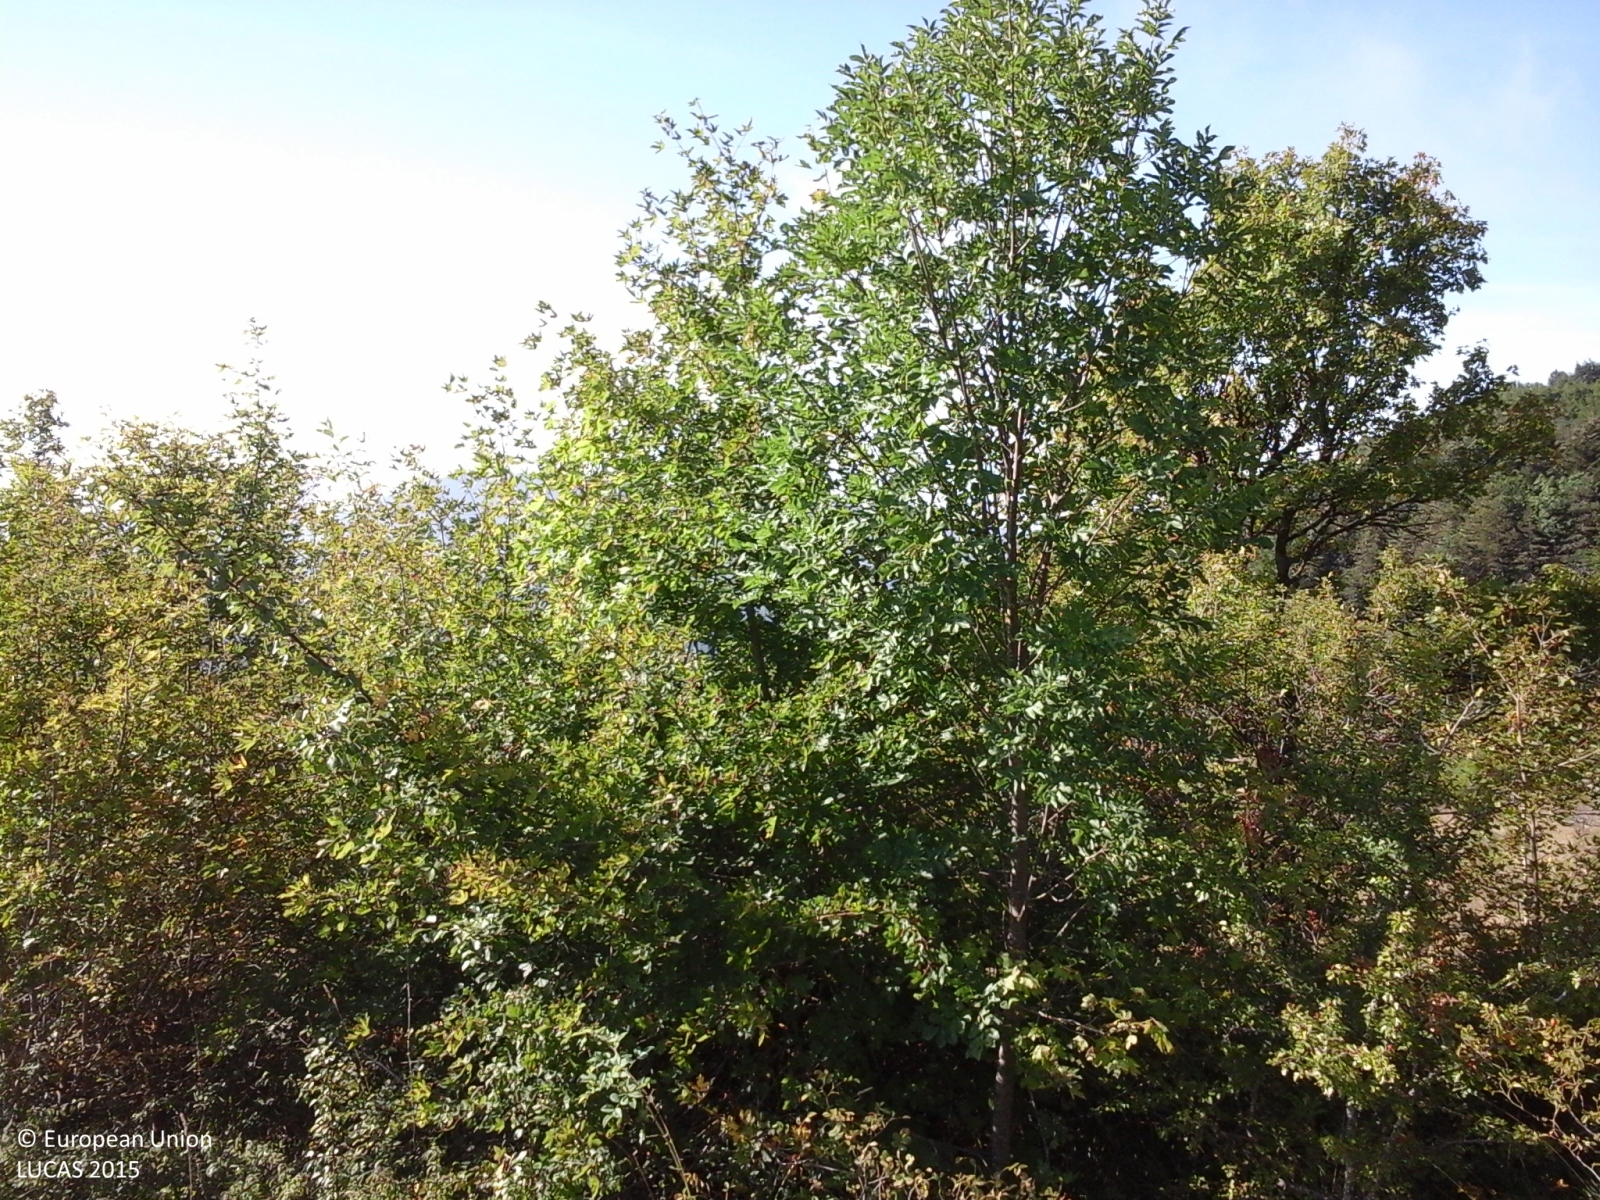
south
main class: Grassland
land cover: Grassland with sparse tree/shrub cover
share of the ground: > 75 %
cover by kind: herbaceous plants 90 %, broadleaved forest trees 5 %, shrubs 5 %
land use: Agriculture (excluding fallow land and kitchen gardens)
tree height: > 5 m
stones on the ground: < 10 %
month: August
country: IT
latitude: 41.7305
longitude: 14.3011
